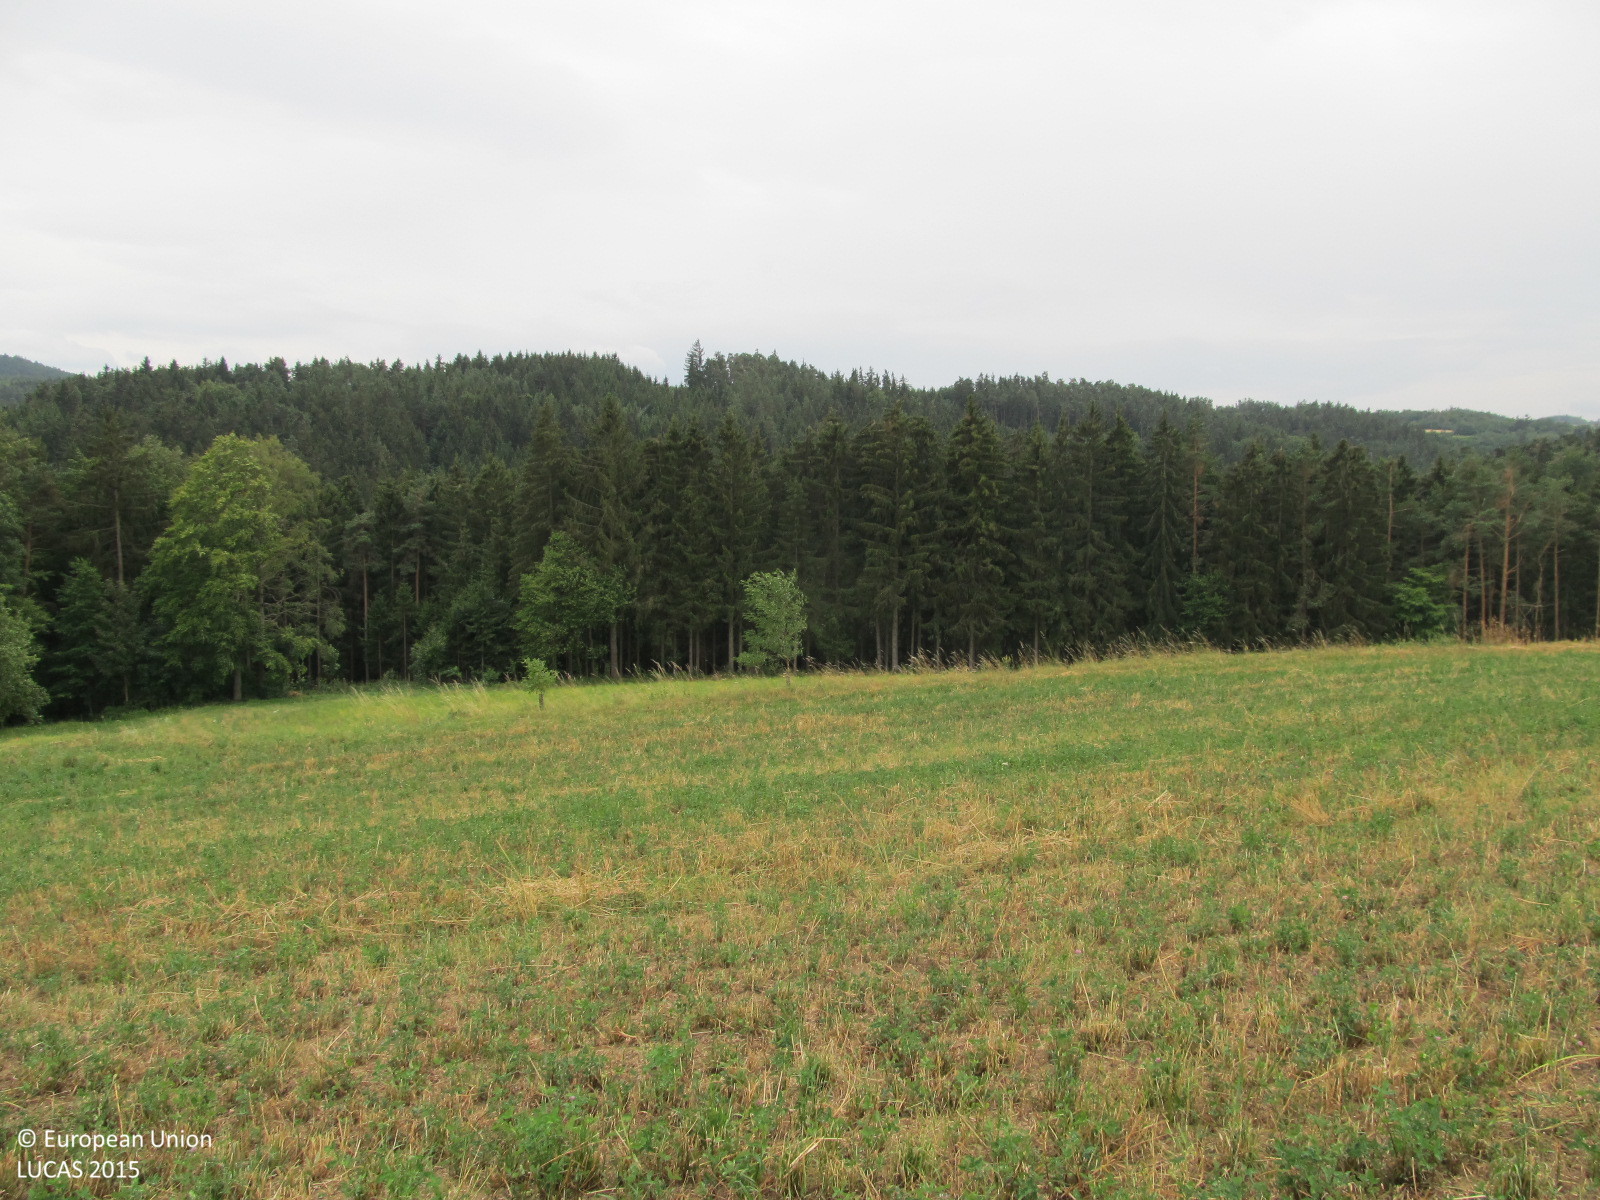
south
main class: Cropland
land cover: Temporary grasslands
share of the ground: > 75 %
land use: Agriculture (excluding fallow land and kitchen gardens)
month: July
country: AT
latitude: 48.4494
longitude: 15.4512
